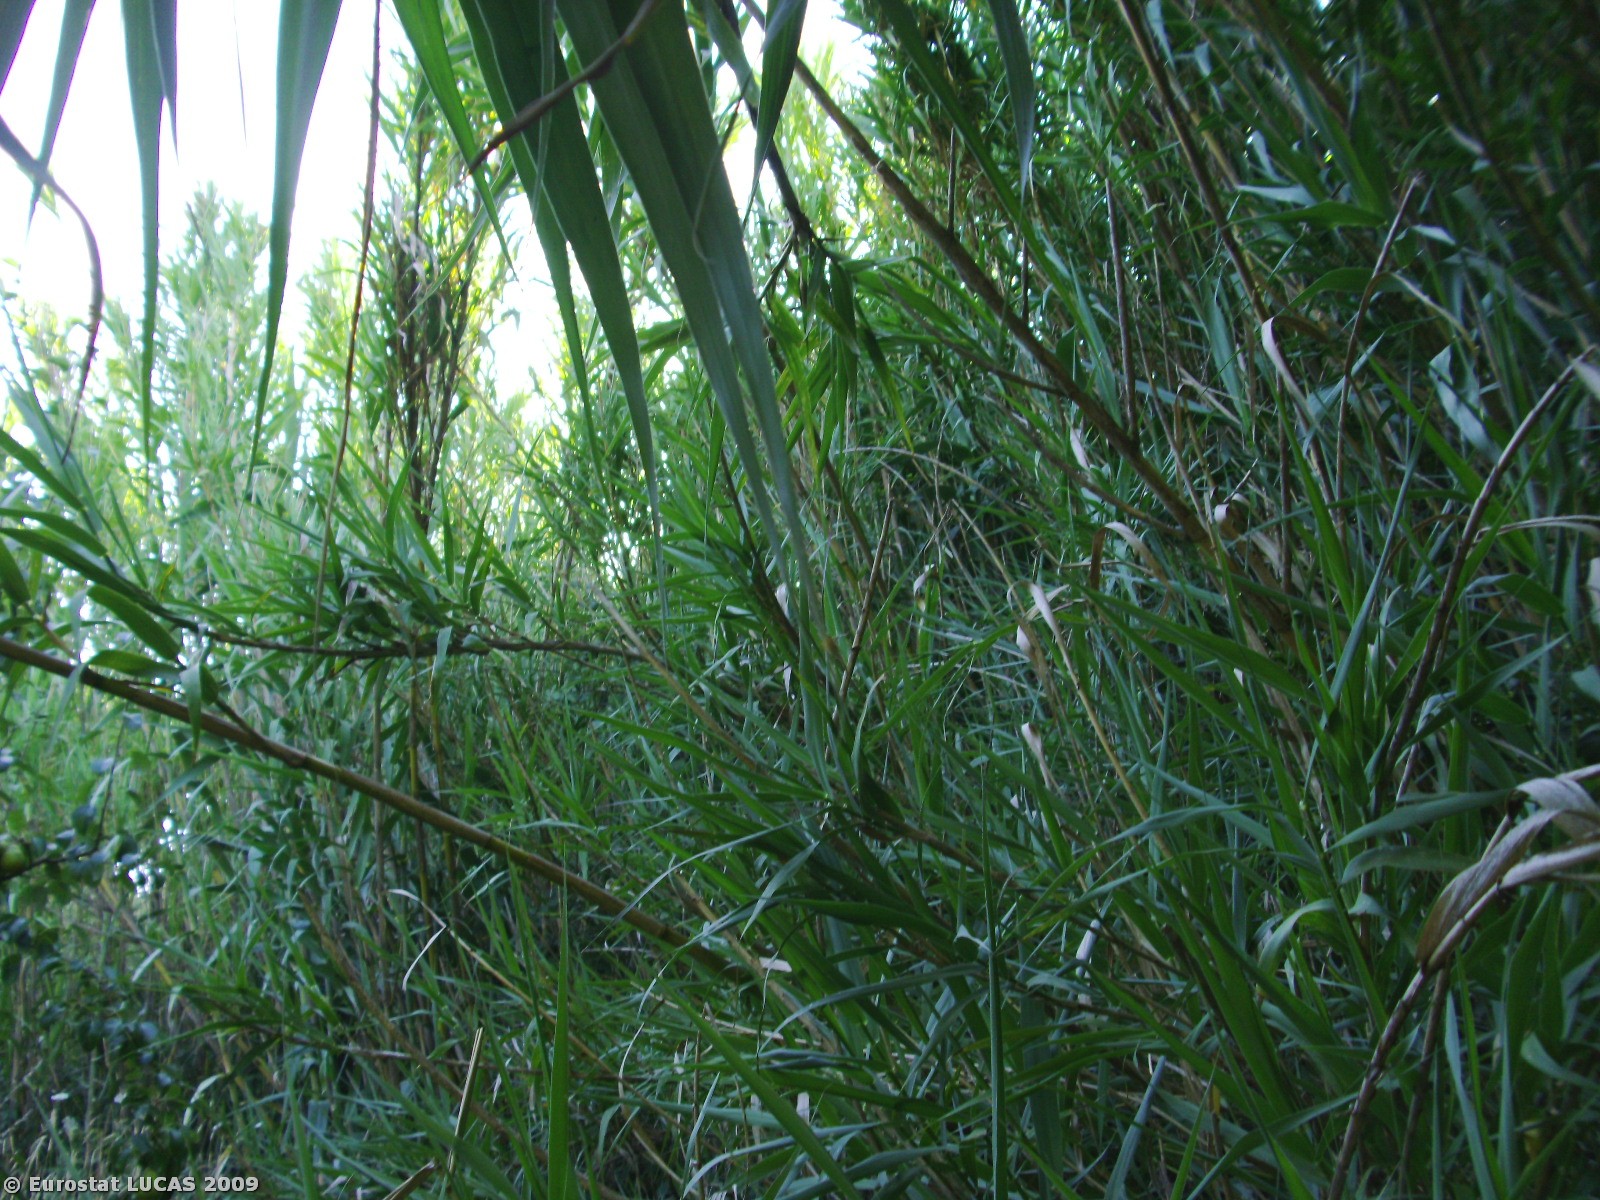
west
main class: Shrubland
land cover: Shrubland with sparse tree cover
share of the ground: > 75 %
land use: Fallow land
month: July
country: PT
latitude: 38.9957
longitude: -9.3099
